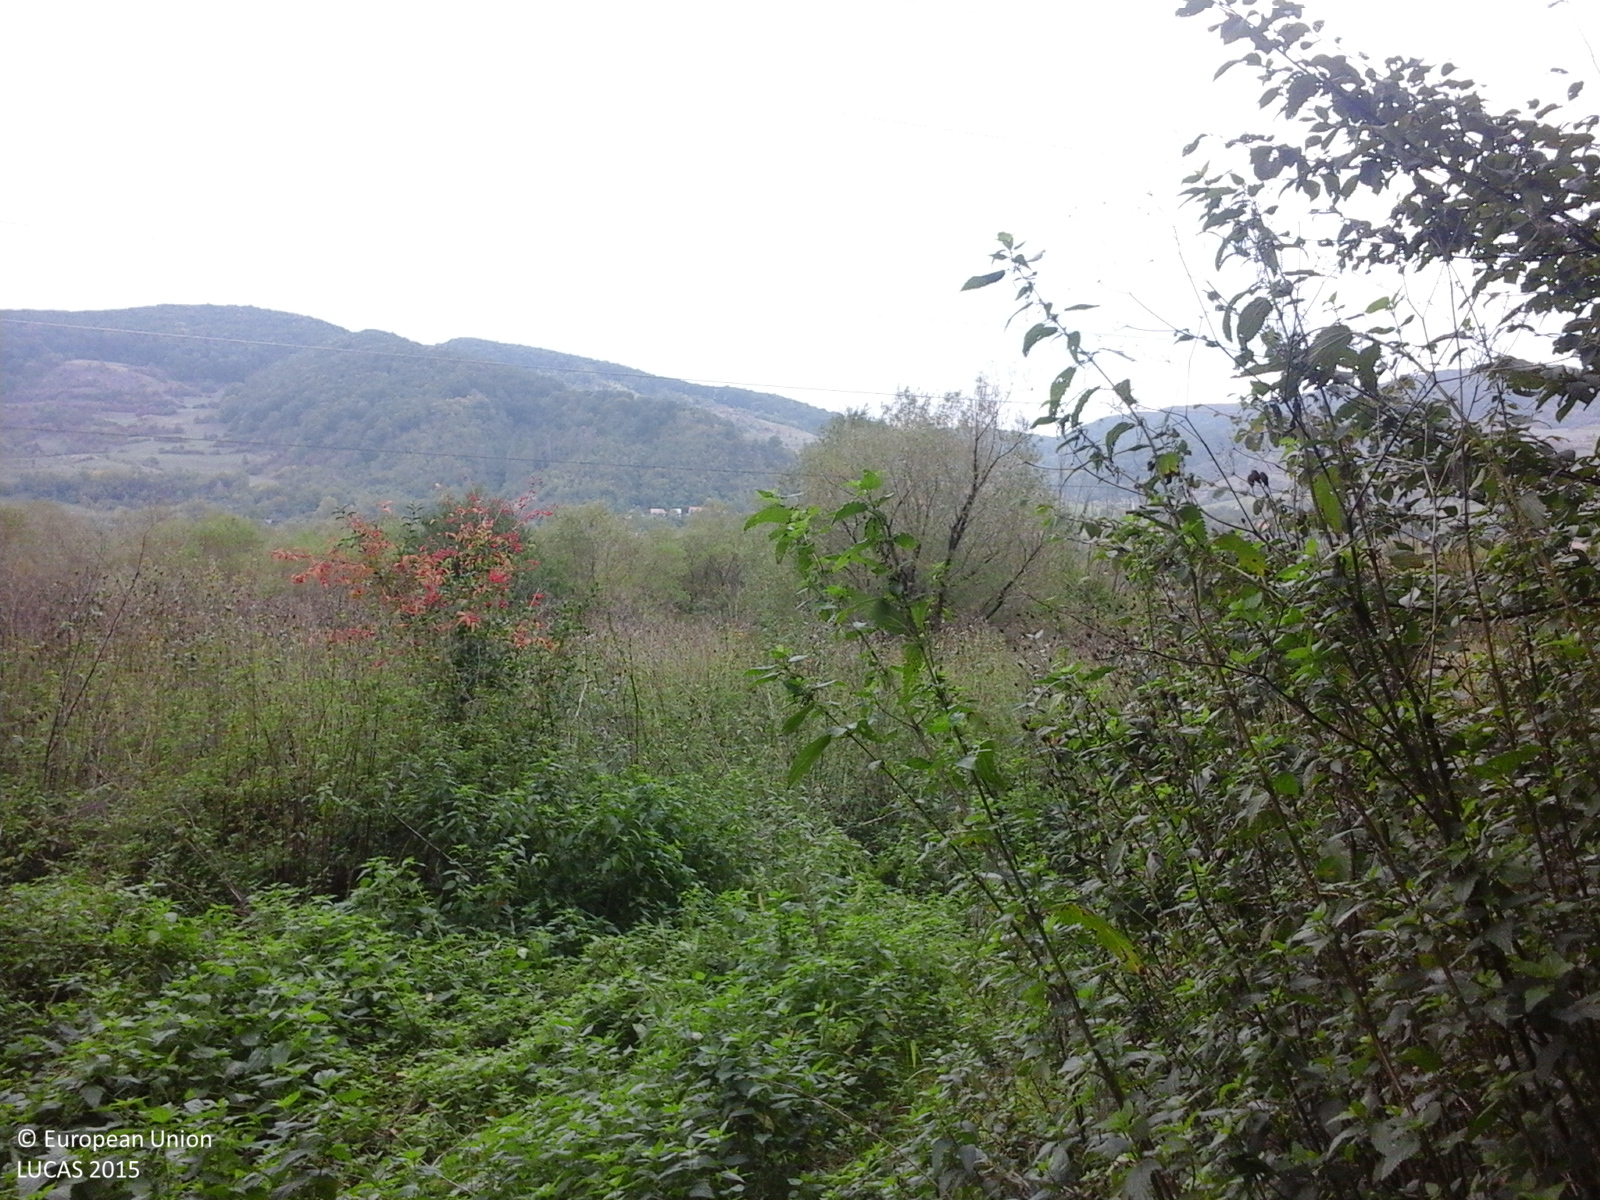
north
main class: Woodland
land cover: Broadleaved woodland
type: mesophytic deciduous forest
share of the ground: > 75 %
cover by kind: broadleaved forest trees 100 %
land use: Forestry
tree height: > 5 m
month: October
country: RO
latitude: 46.7744
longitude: 24.8289
